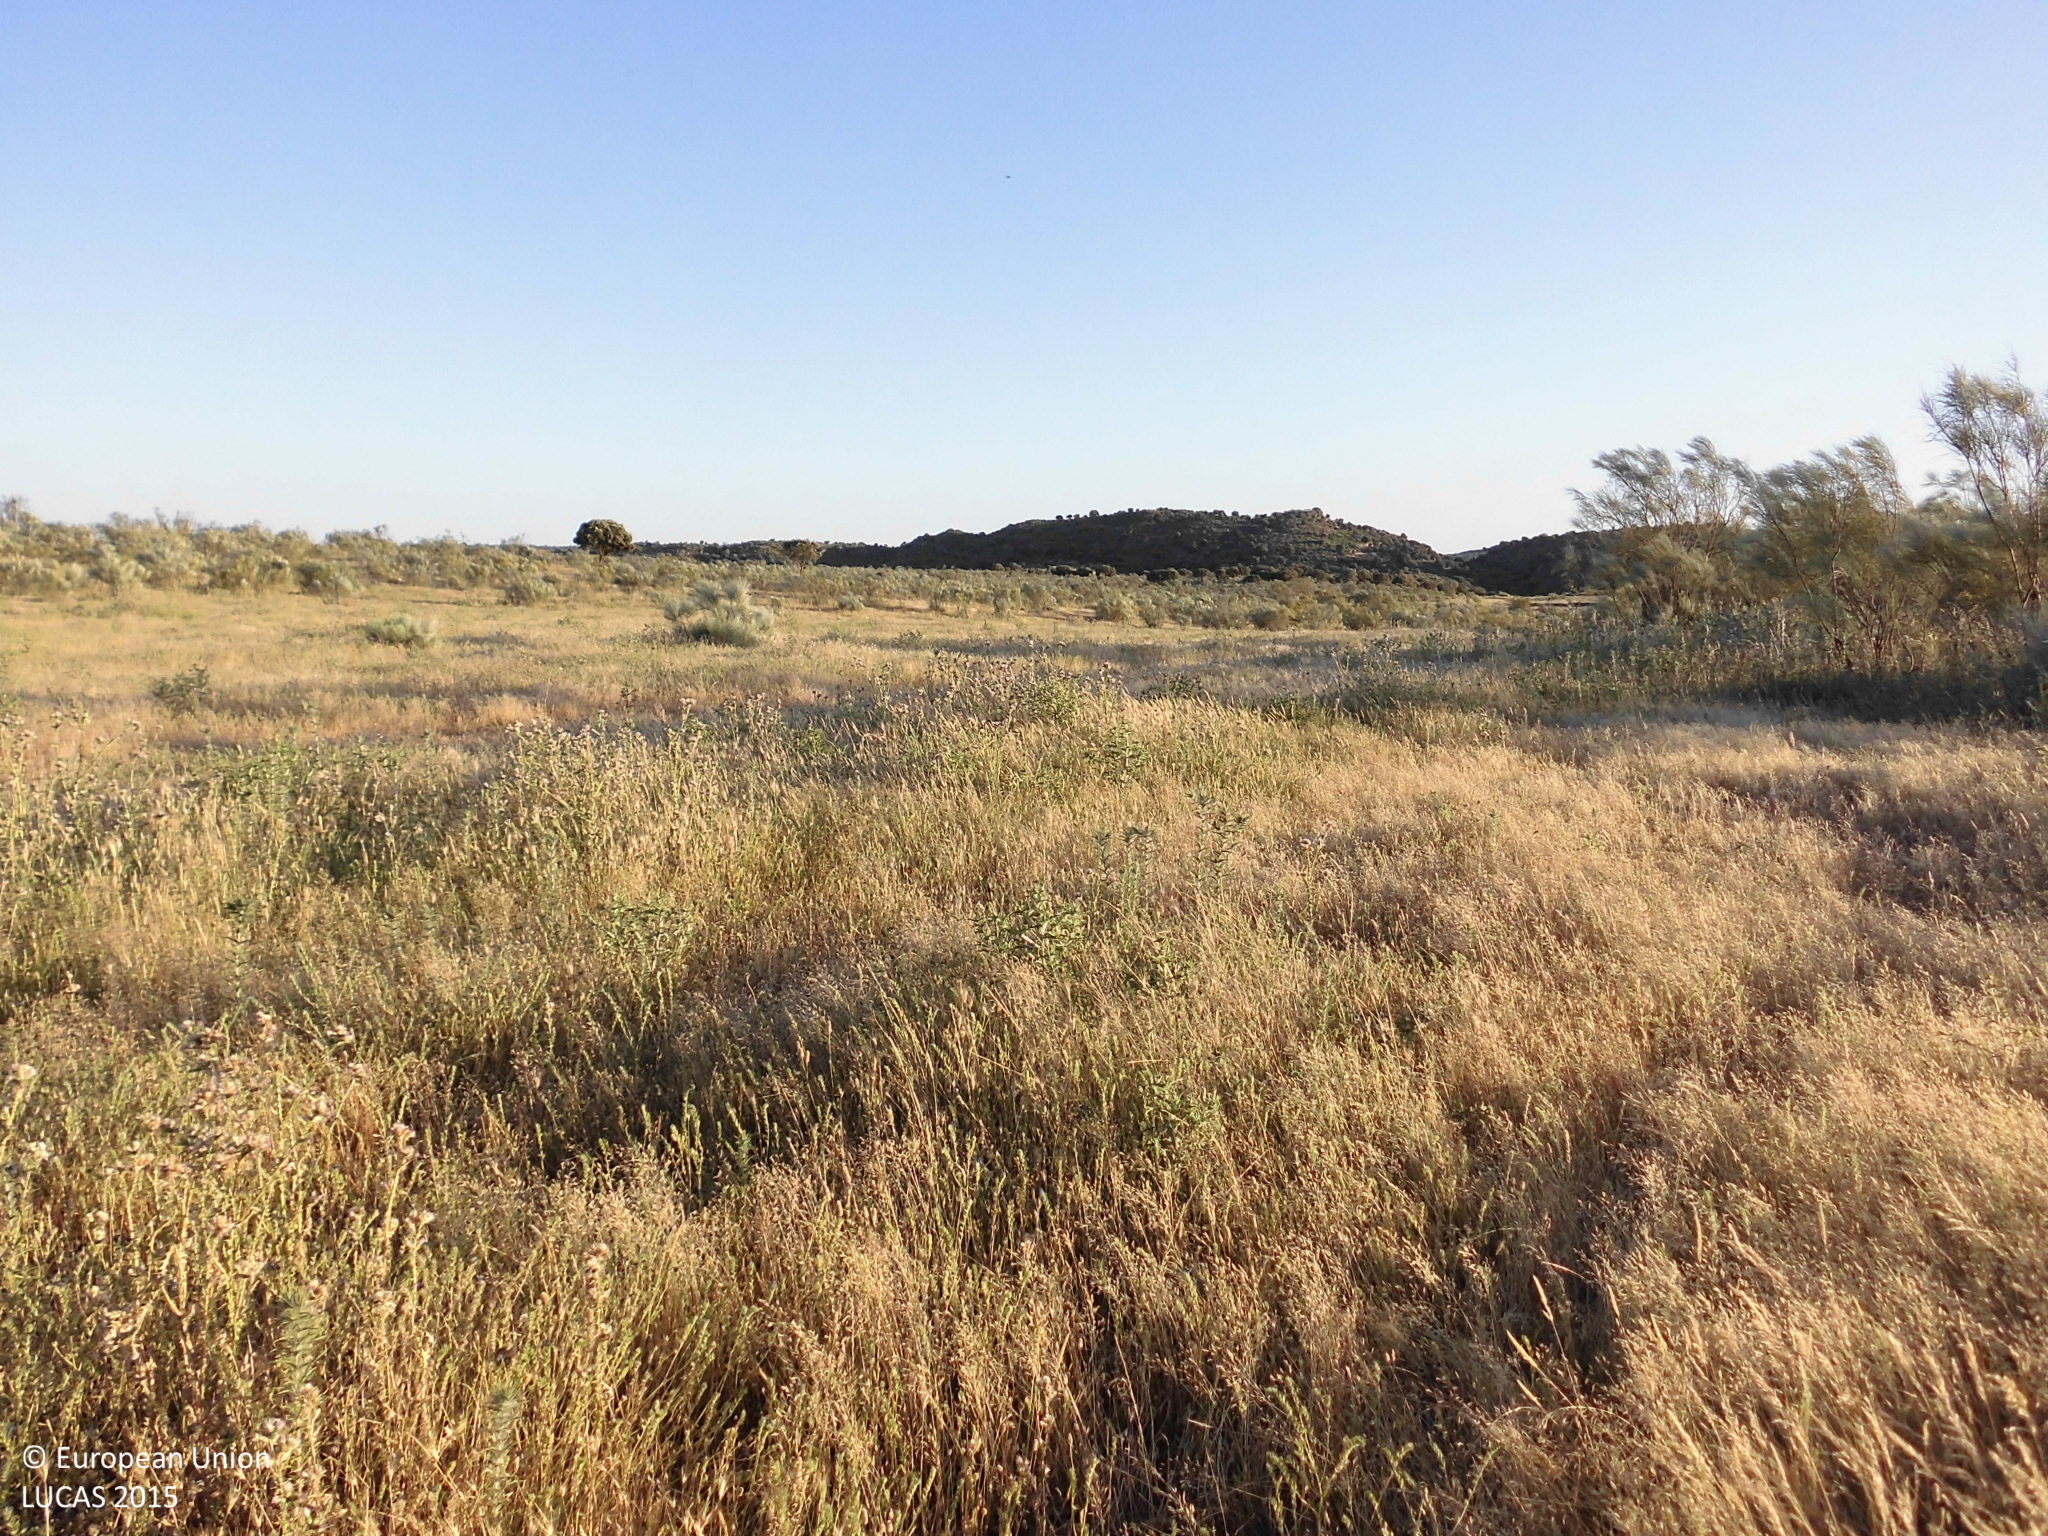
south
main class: Shrubland
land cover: Shrubland without tree cover
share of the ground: 10 - 25 %
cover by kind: herbaceous plants 85 %, shrubs 15 %
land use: Agriculture (excluding fallow land and kitchen gardens)
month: May
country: ES
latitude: 39.4394
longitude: -6.0130
